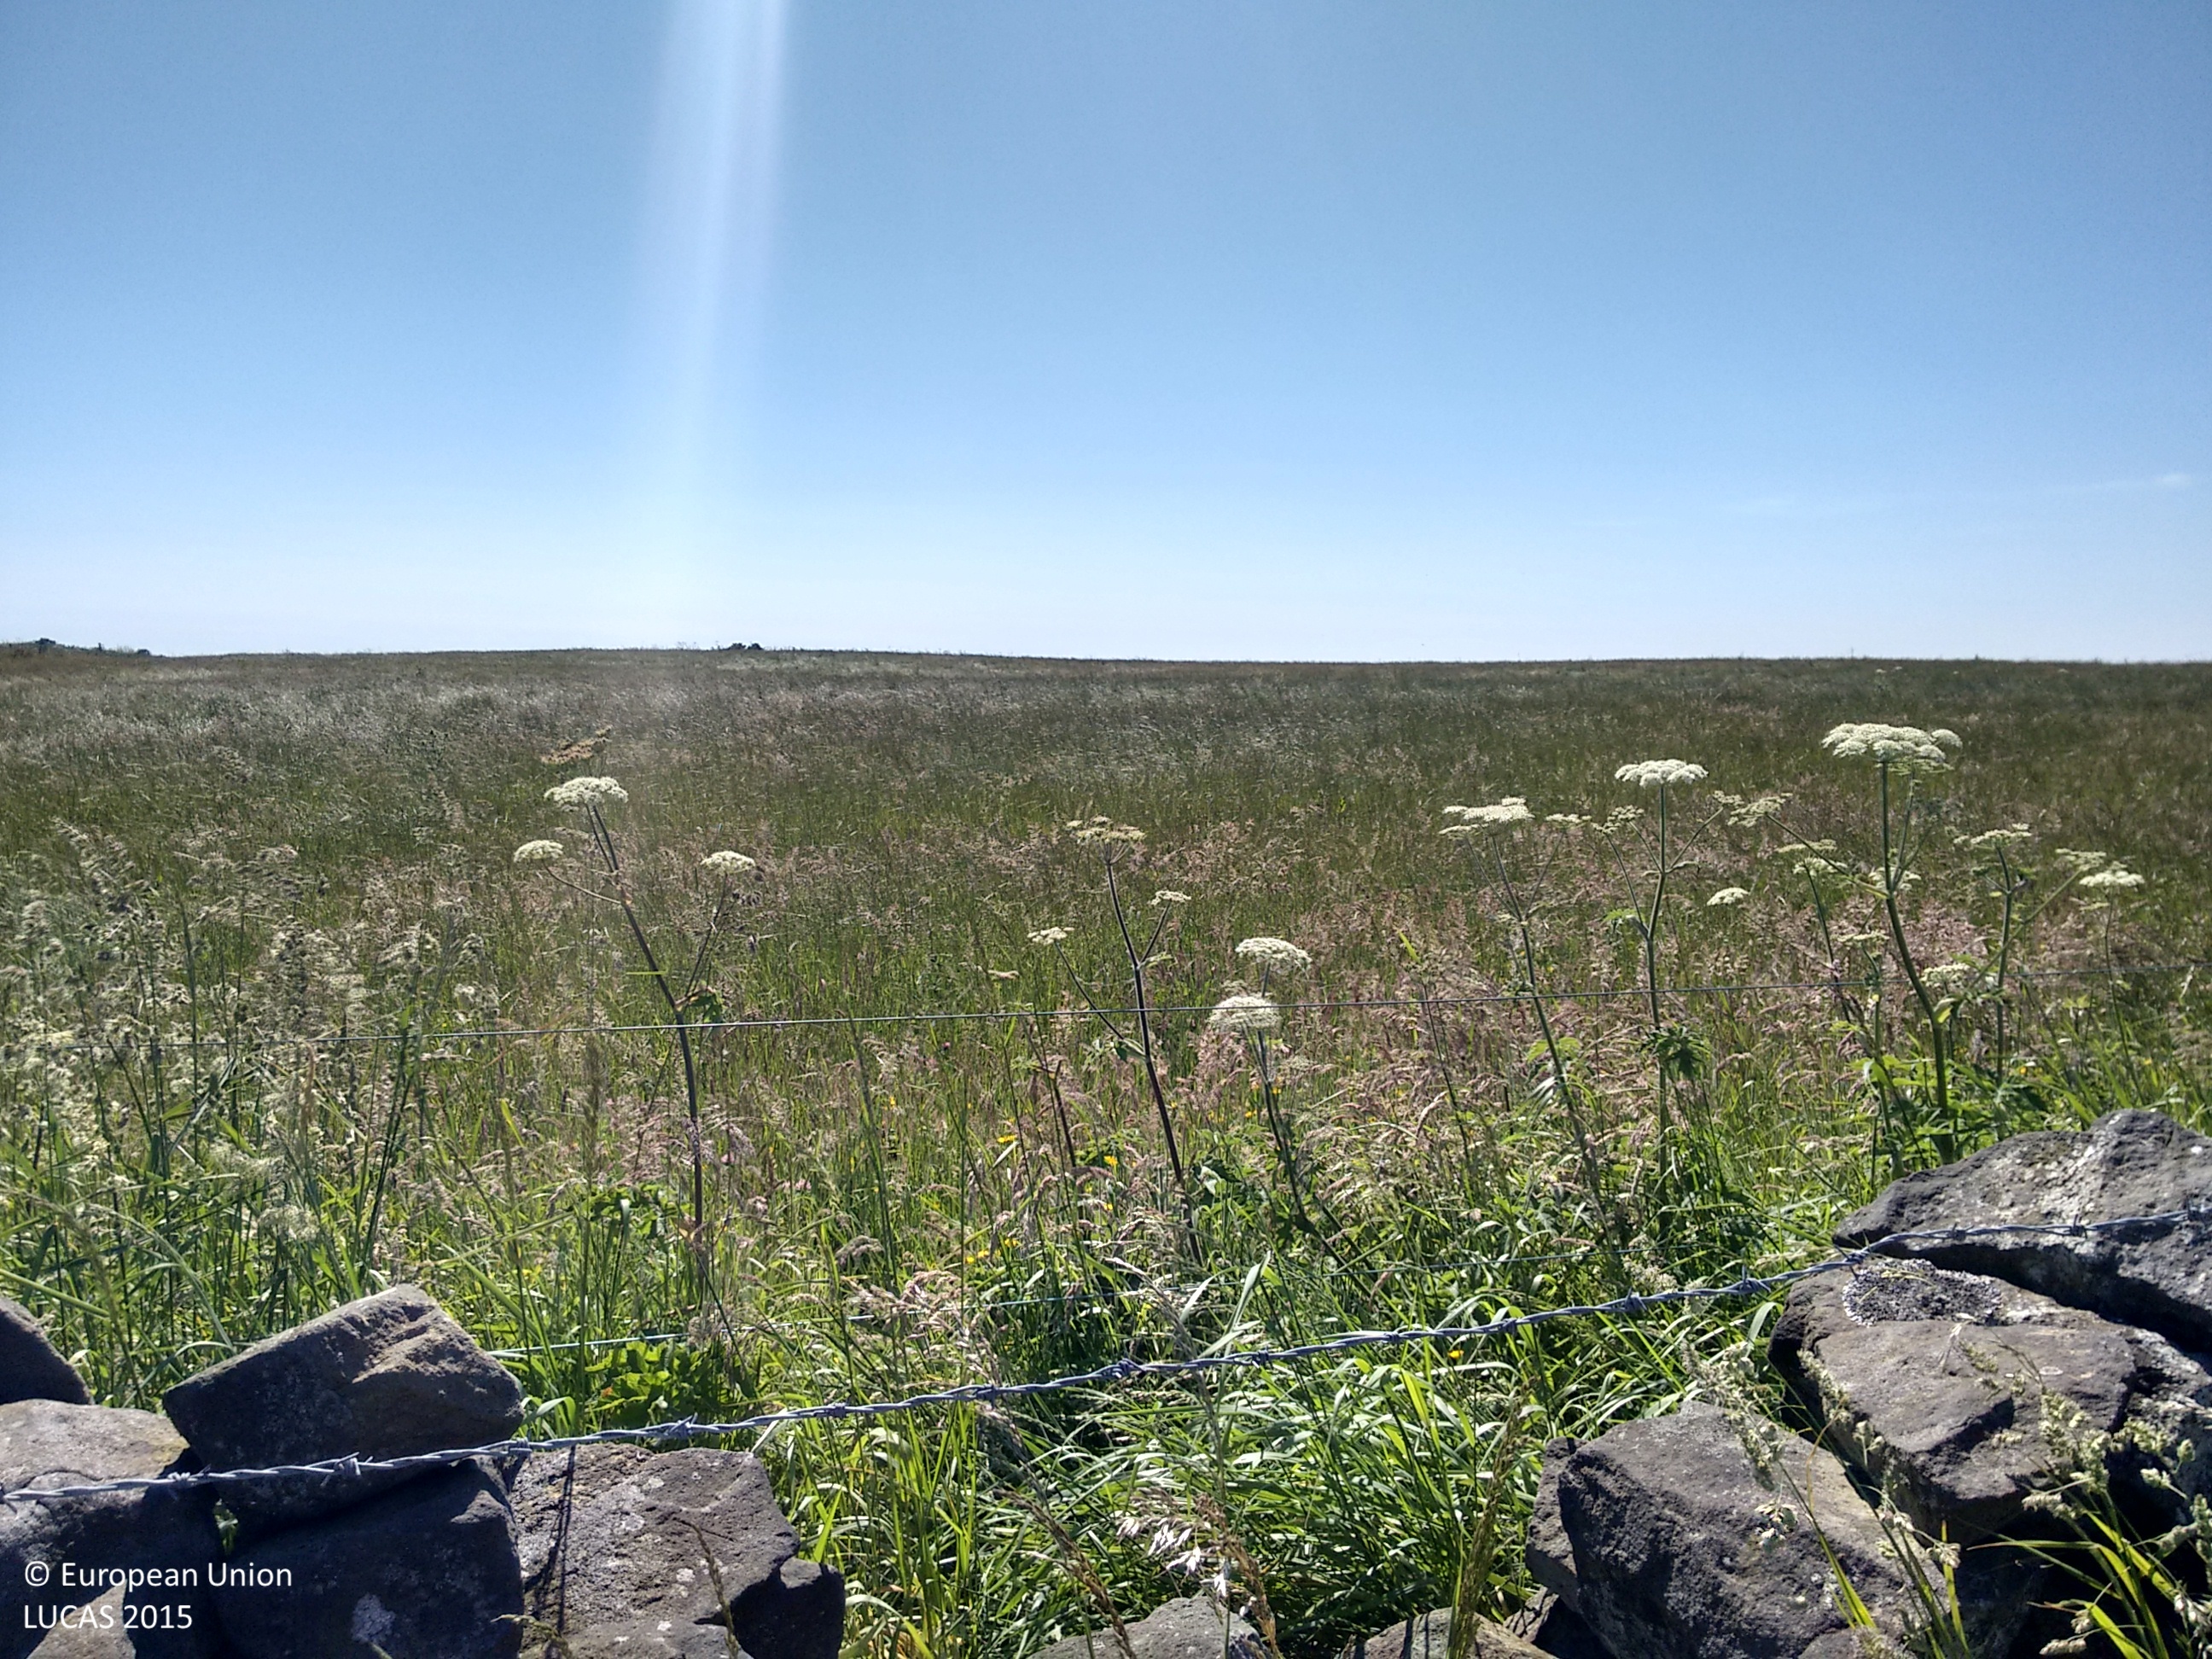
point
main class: Cropland
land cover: Temporary grasslands
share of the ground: > 75 %
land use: Agriculture (excluding fallow land and kitchen gardens)
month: July
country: GB
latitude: 54.3957
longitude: -0.4939
